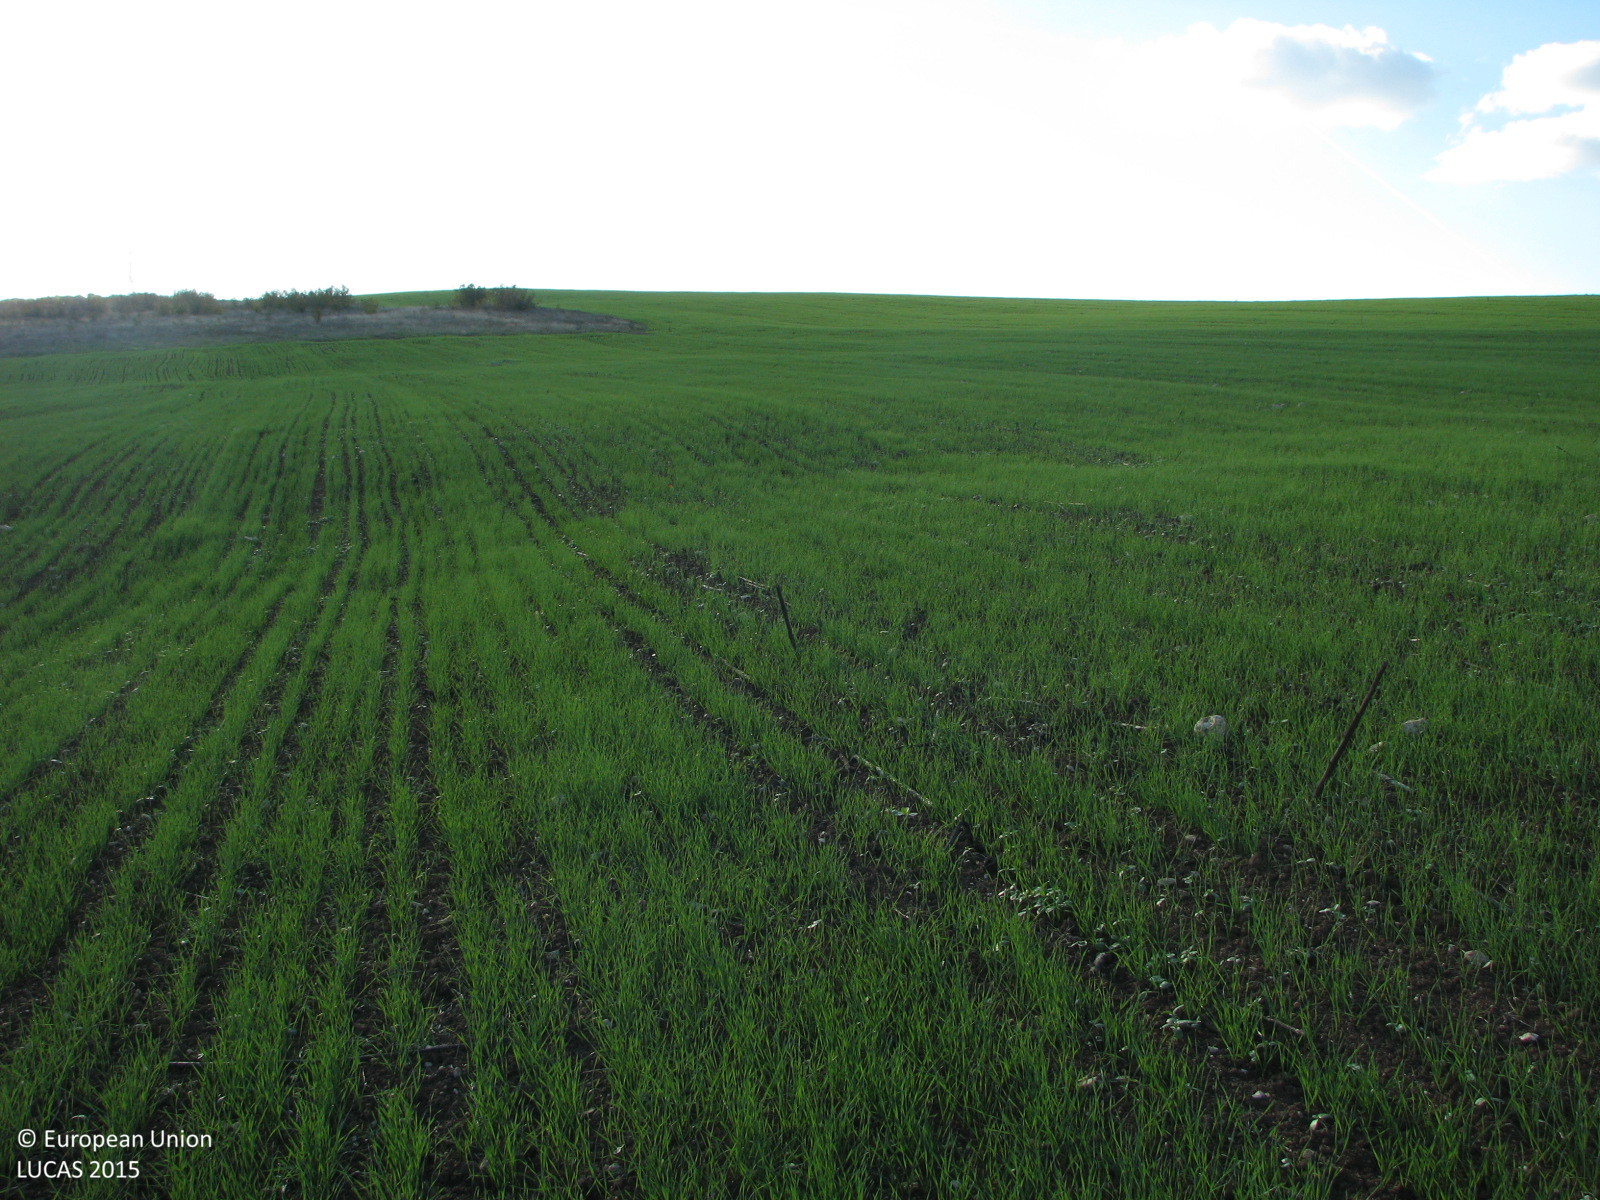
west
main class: Cropland
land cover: Common wheat
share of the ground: 50 - 75 %
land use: Agriculture (excluding fallow land and kitchen gardens)
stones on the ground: < 10 %
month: October
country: BG
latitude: 42.1020
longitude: 26.3722
